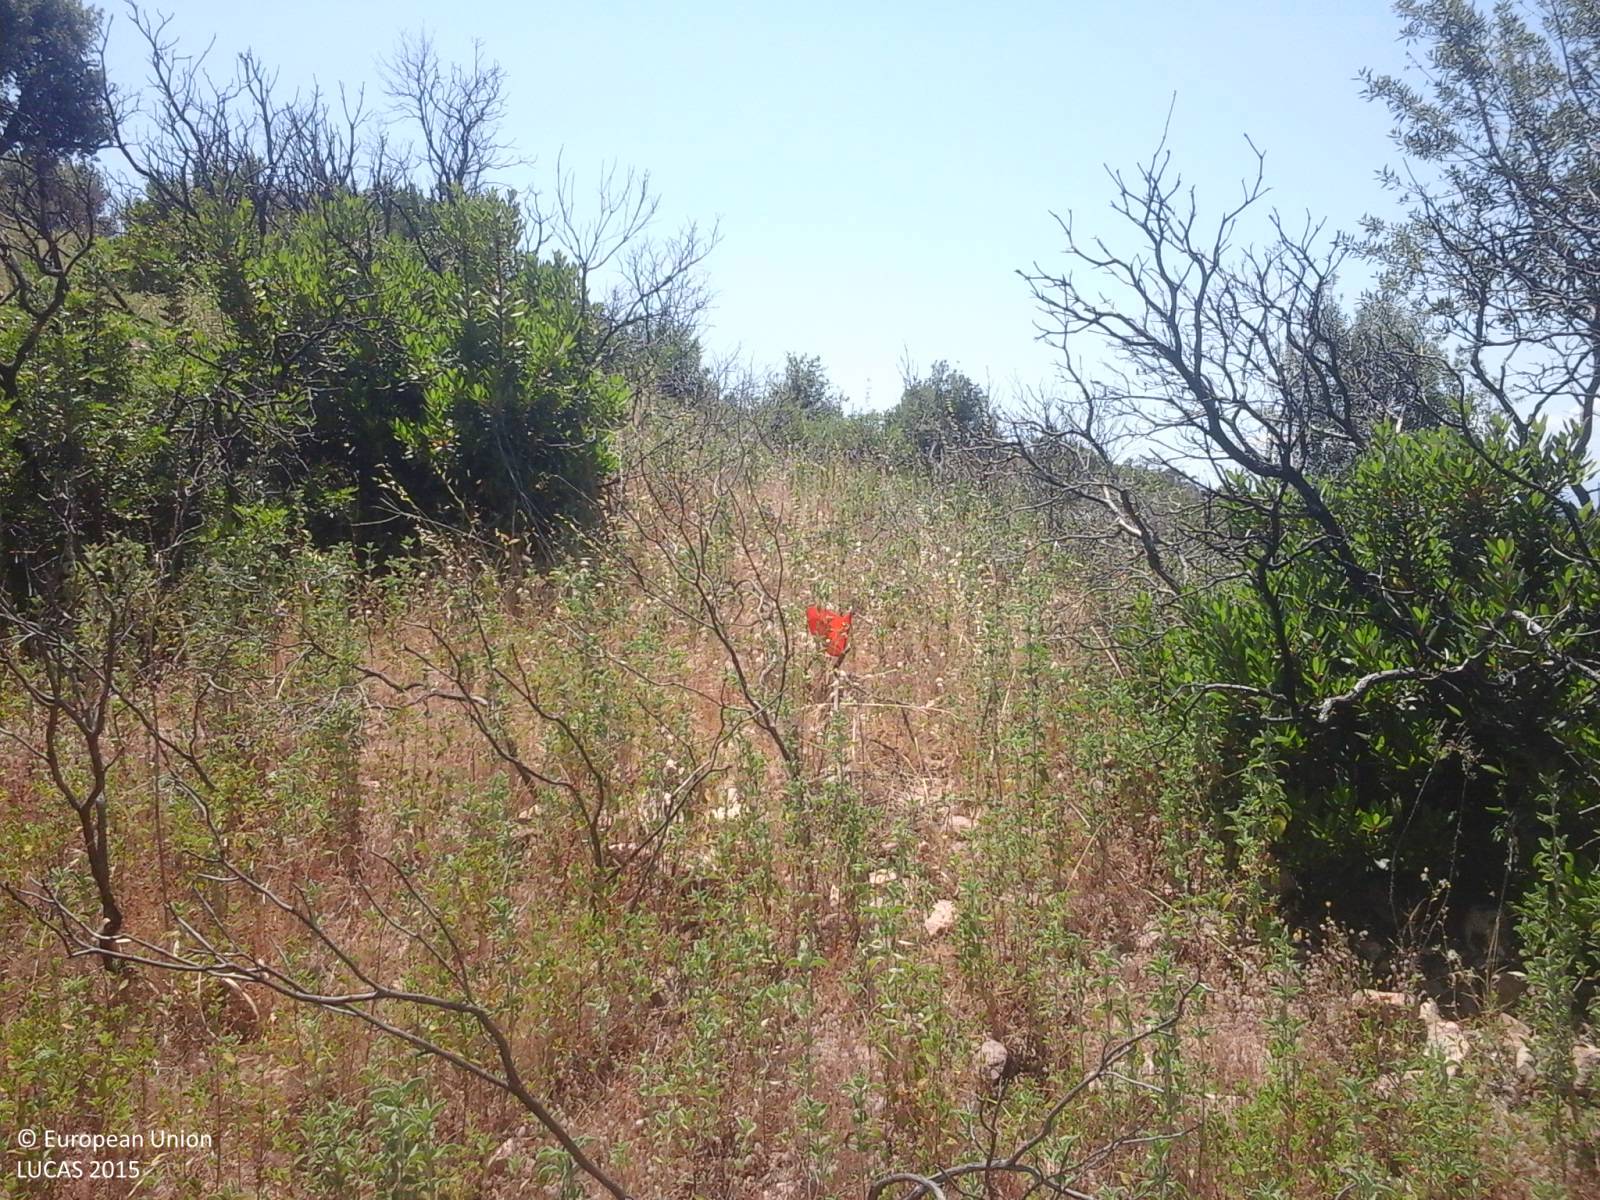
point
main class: Shrubland
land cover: Shrubland with sparse tree cover
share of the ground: > 75 %
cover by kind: herbaceous plants 80 %, shrubs 15 %, broadleaved forest trees 5 %
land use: Semi-natural and natural areas not in use
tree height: < 5 m
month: June
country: IT
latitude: 39.2871
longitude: 9.3432
